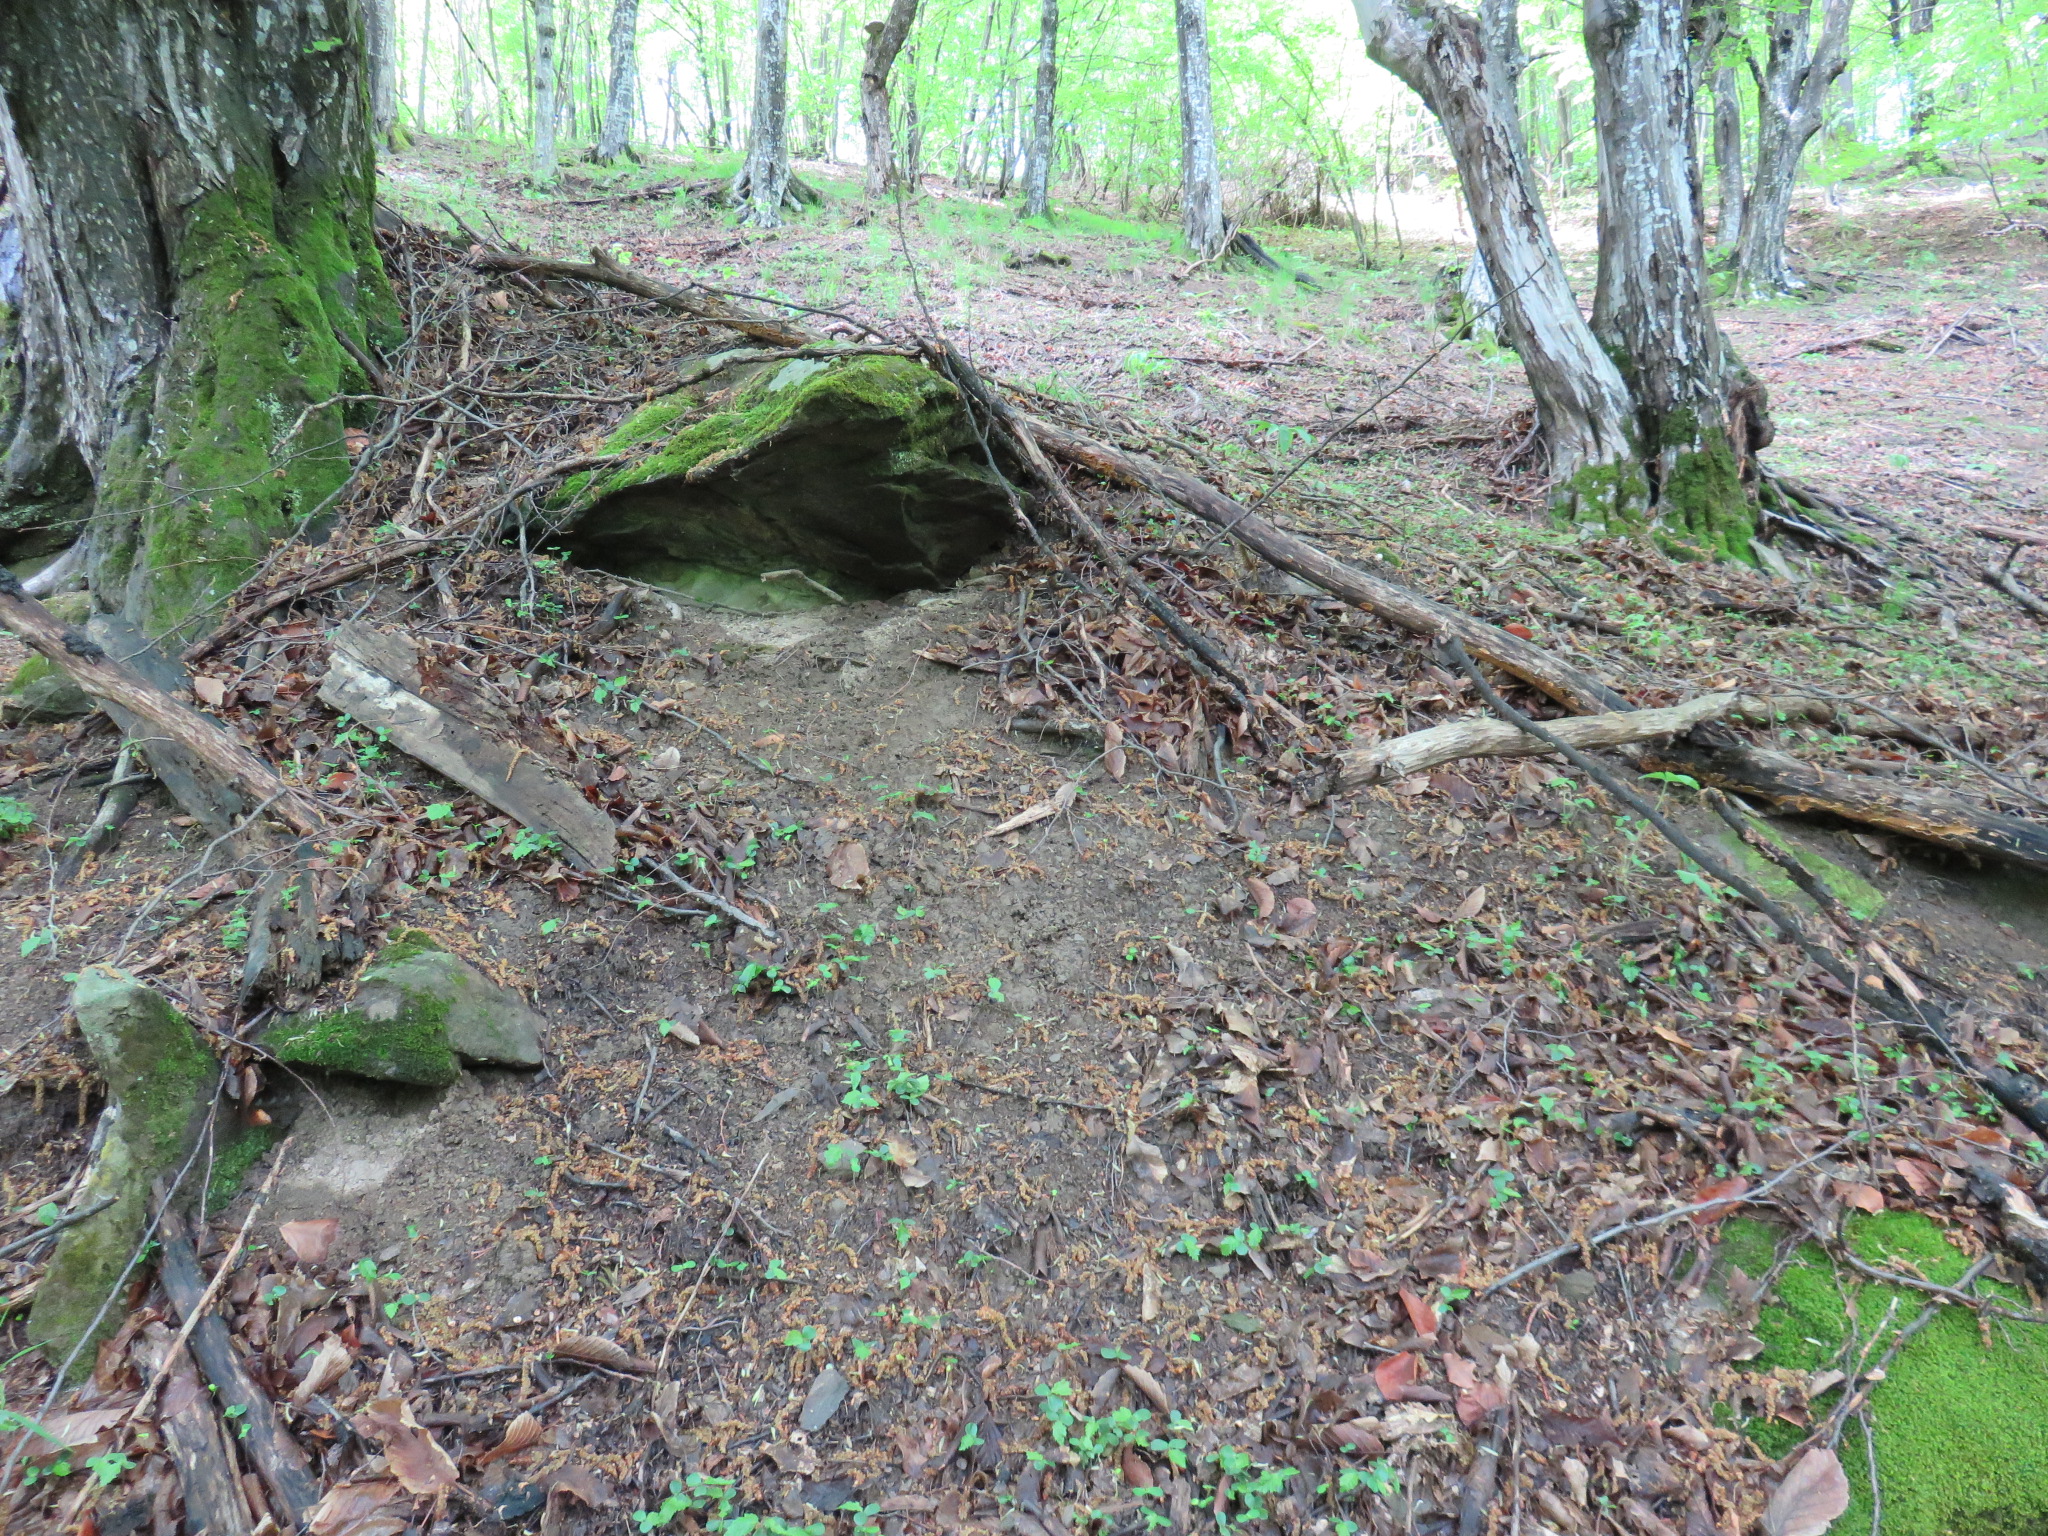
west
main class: Woodland
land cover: Broadleaved woodland
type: beech forest
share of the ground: > 75 %
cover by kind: broadleaved forest trees 80 %, unconsolidated bare surface 20 %
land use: Forestry
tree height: > 5 m
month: May
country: BG
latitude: 42.8068
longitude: 24.7951
